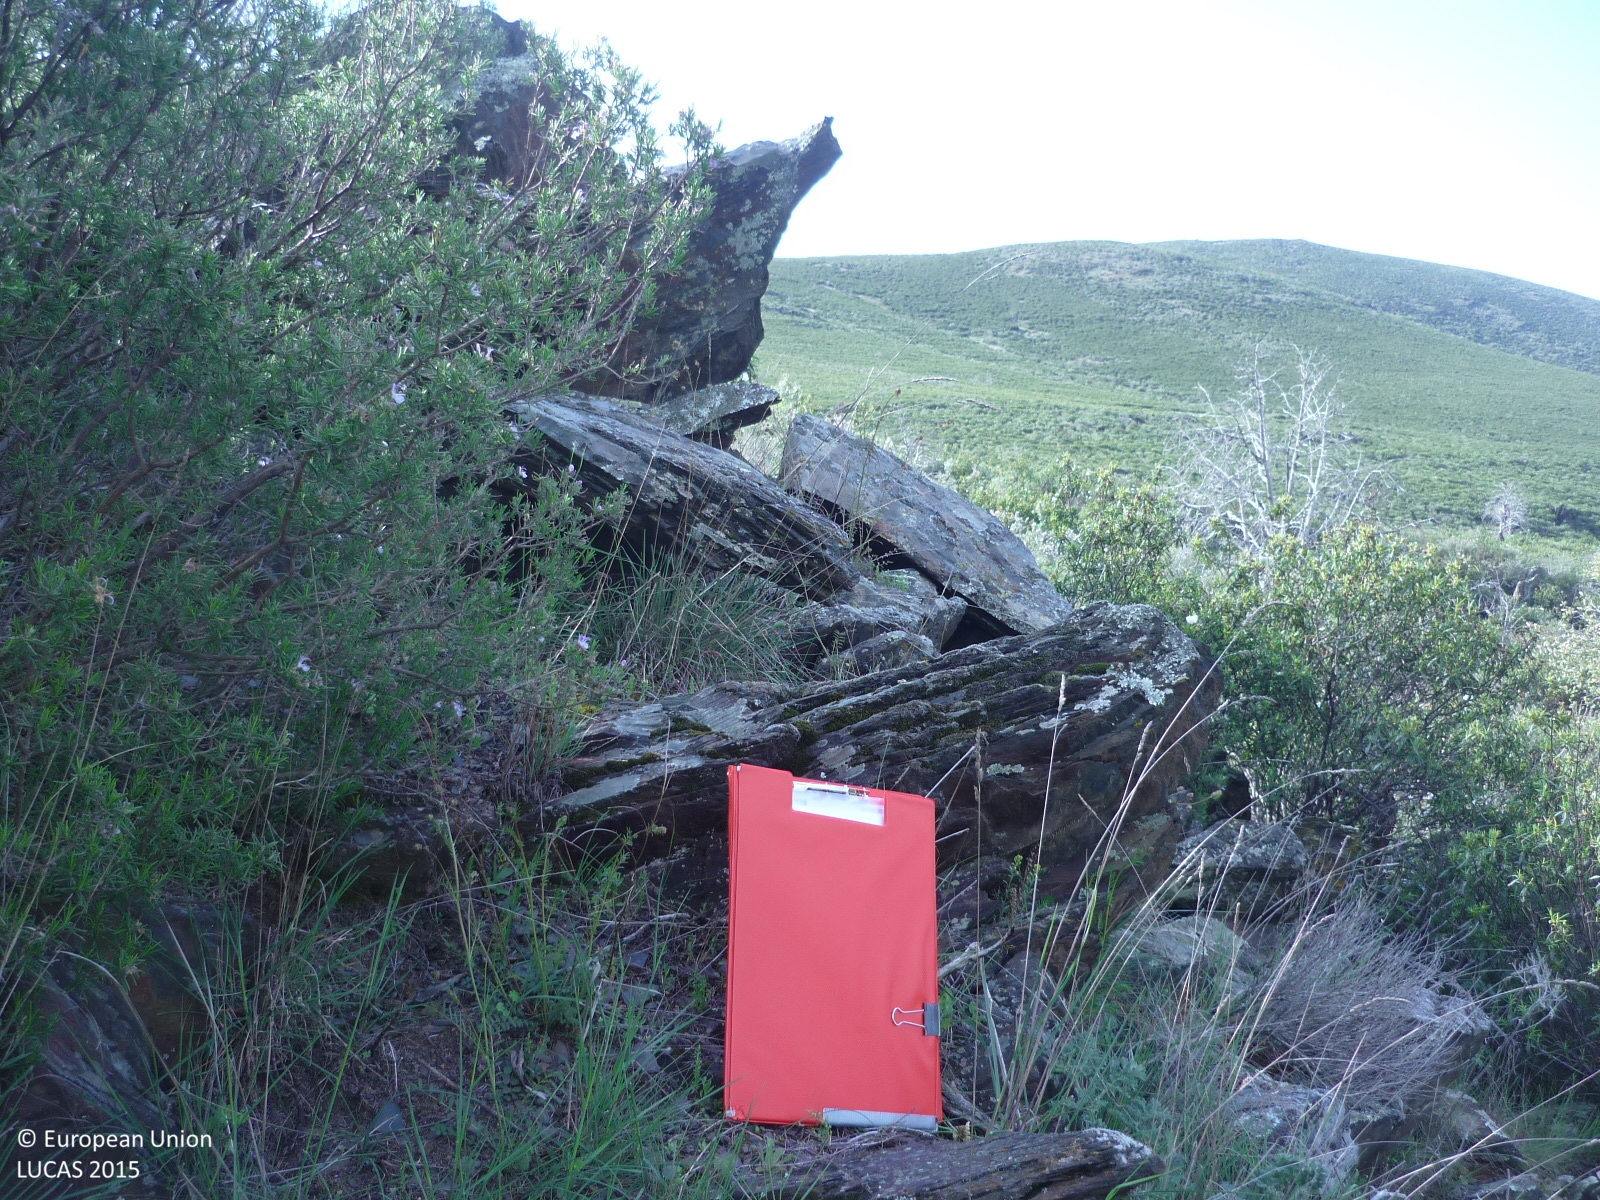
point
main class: Shrubland
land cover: Shrubland without tree cover
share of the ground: > 75 %
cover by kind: shrubs 90 %, herbaceous plants 10 %
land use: Semi-natural and natural areas not in use
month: April
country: ES
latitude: 40.8843
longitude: -3.5108
